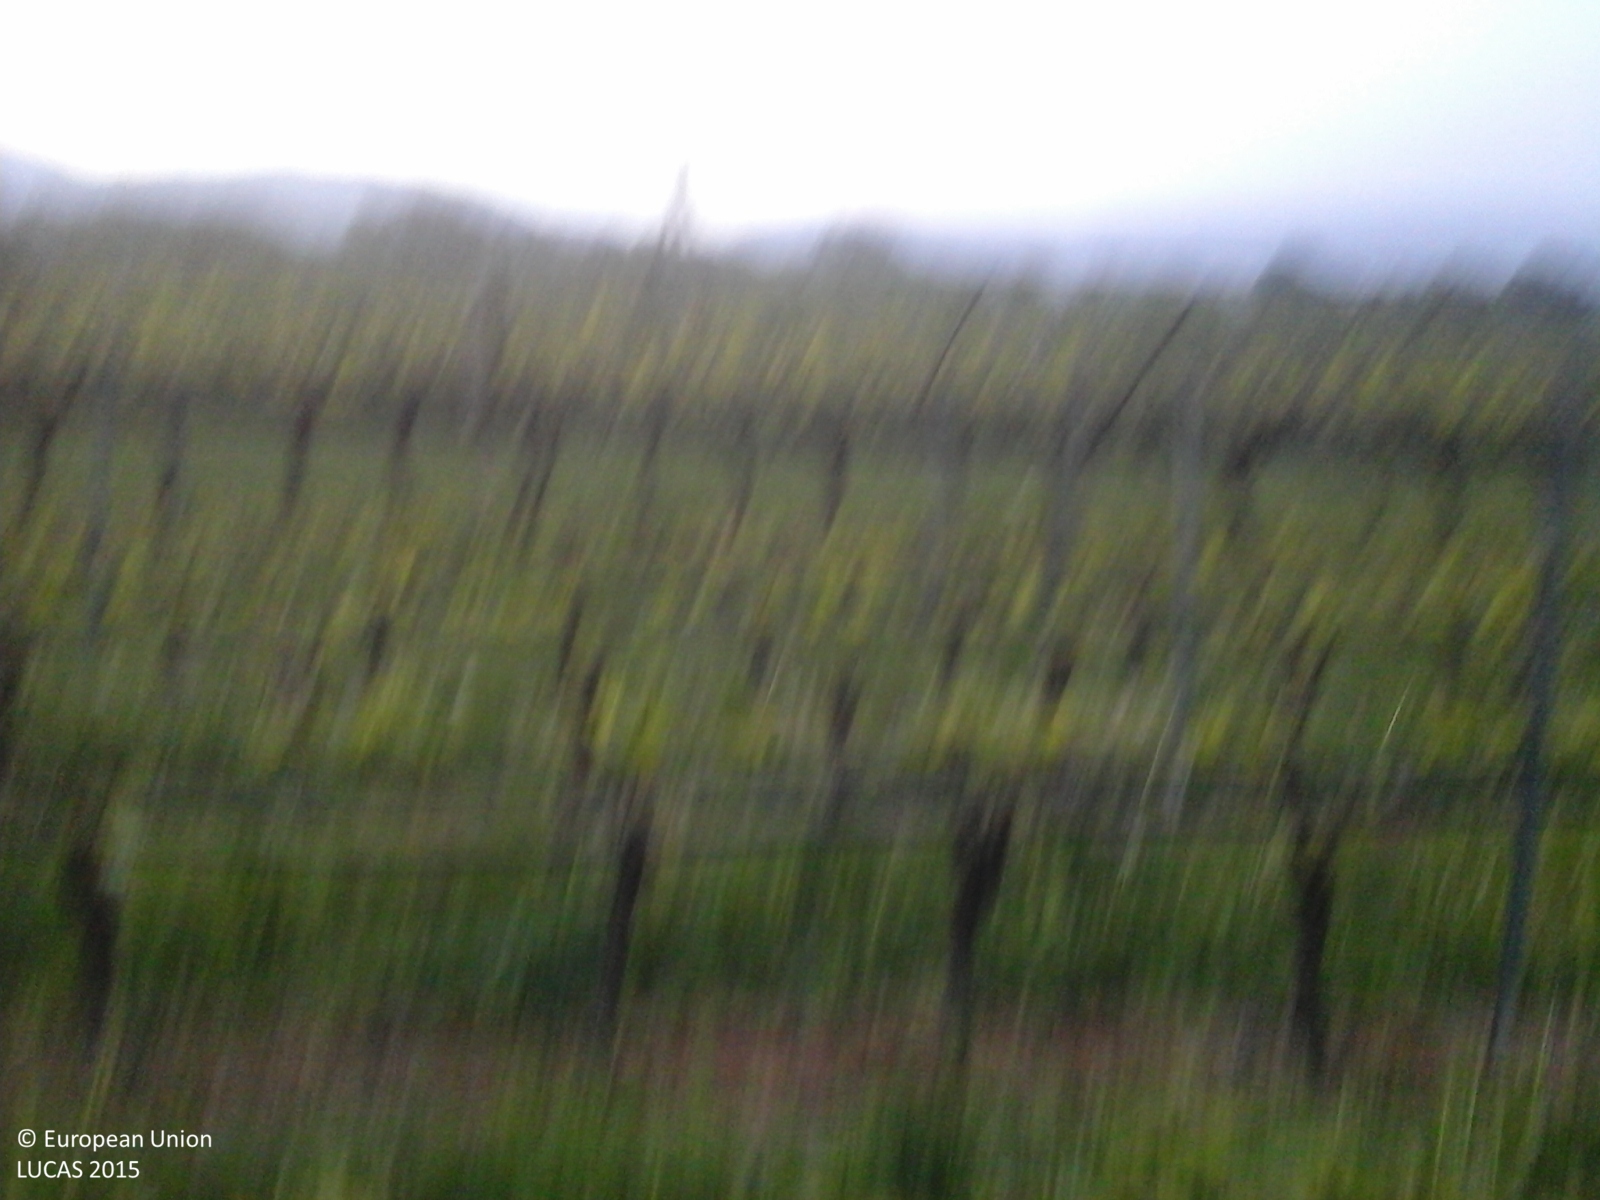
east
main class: Cropland
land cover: Vineyards
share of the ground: < 10 %
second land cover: Grassland without tree/shrub cover
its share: > 75 %
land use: Agriculture (excluding fallow land and kitchen gardens)
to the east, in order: Vineyards; Grassland without tree/shrub cover; Apple fruit; Vineyards; Other fresh vegetables; Grass margins; Paved roads, cycling and walking lanes; Grass margins; Broadleaved woodland; Inland fresh running water
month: April
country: IT
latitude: 46.1477
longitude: 11.0731
